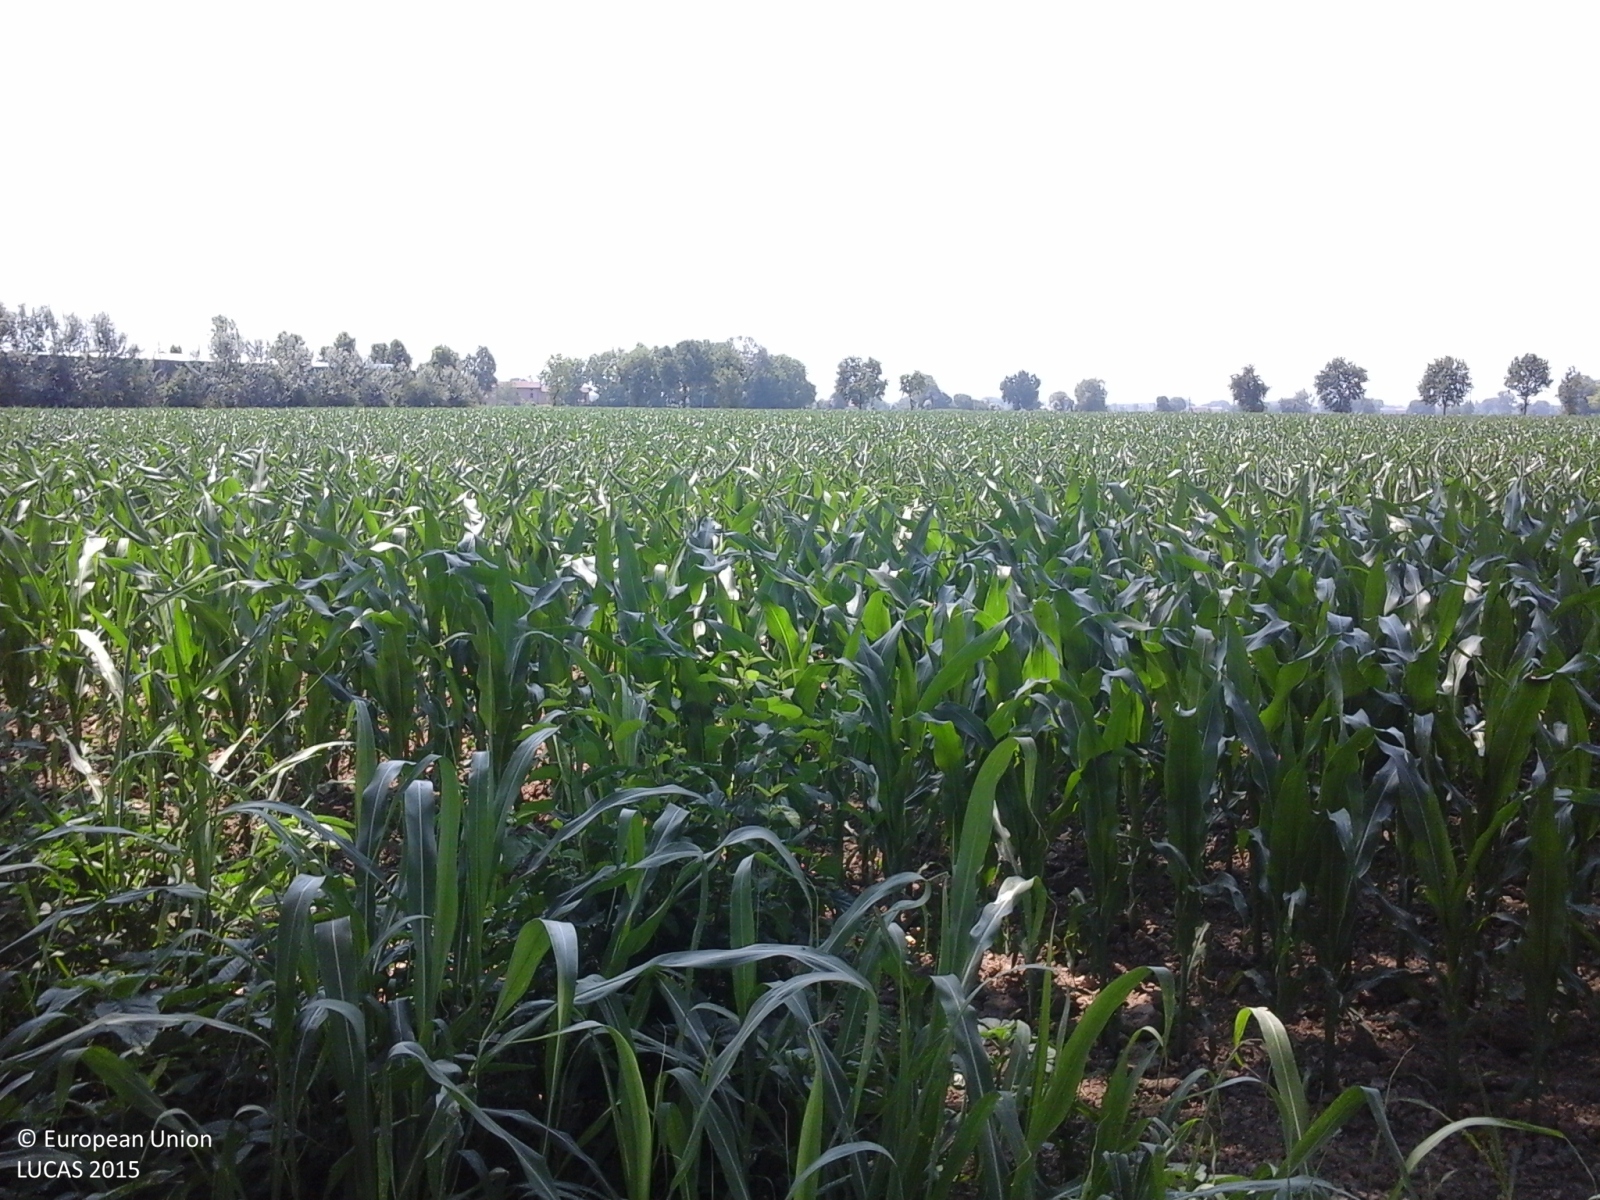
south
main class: Woodland
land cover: Broadleaved woodland
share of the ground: > 75 %
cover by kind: broadleaved forest trees 100 %
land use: Forestry
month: June
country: IT
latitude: 45.1438
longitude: 9.8604
